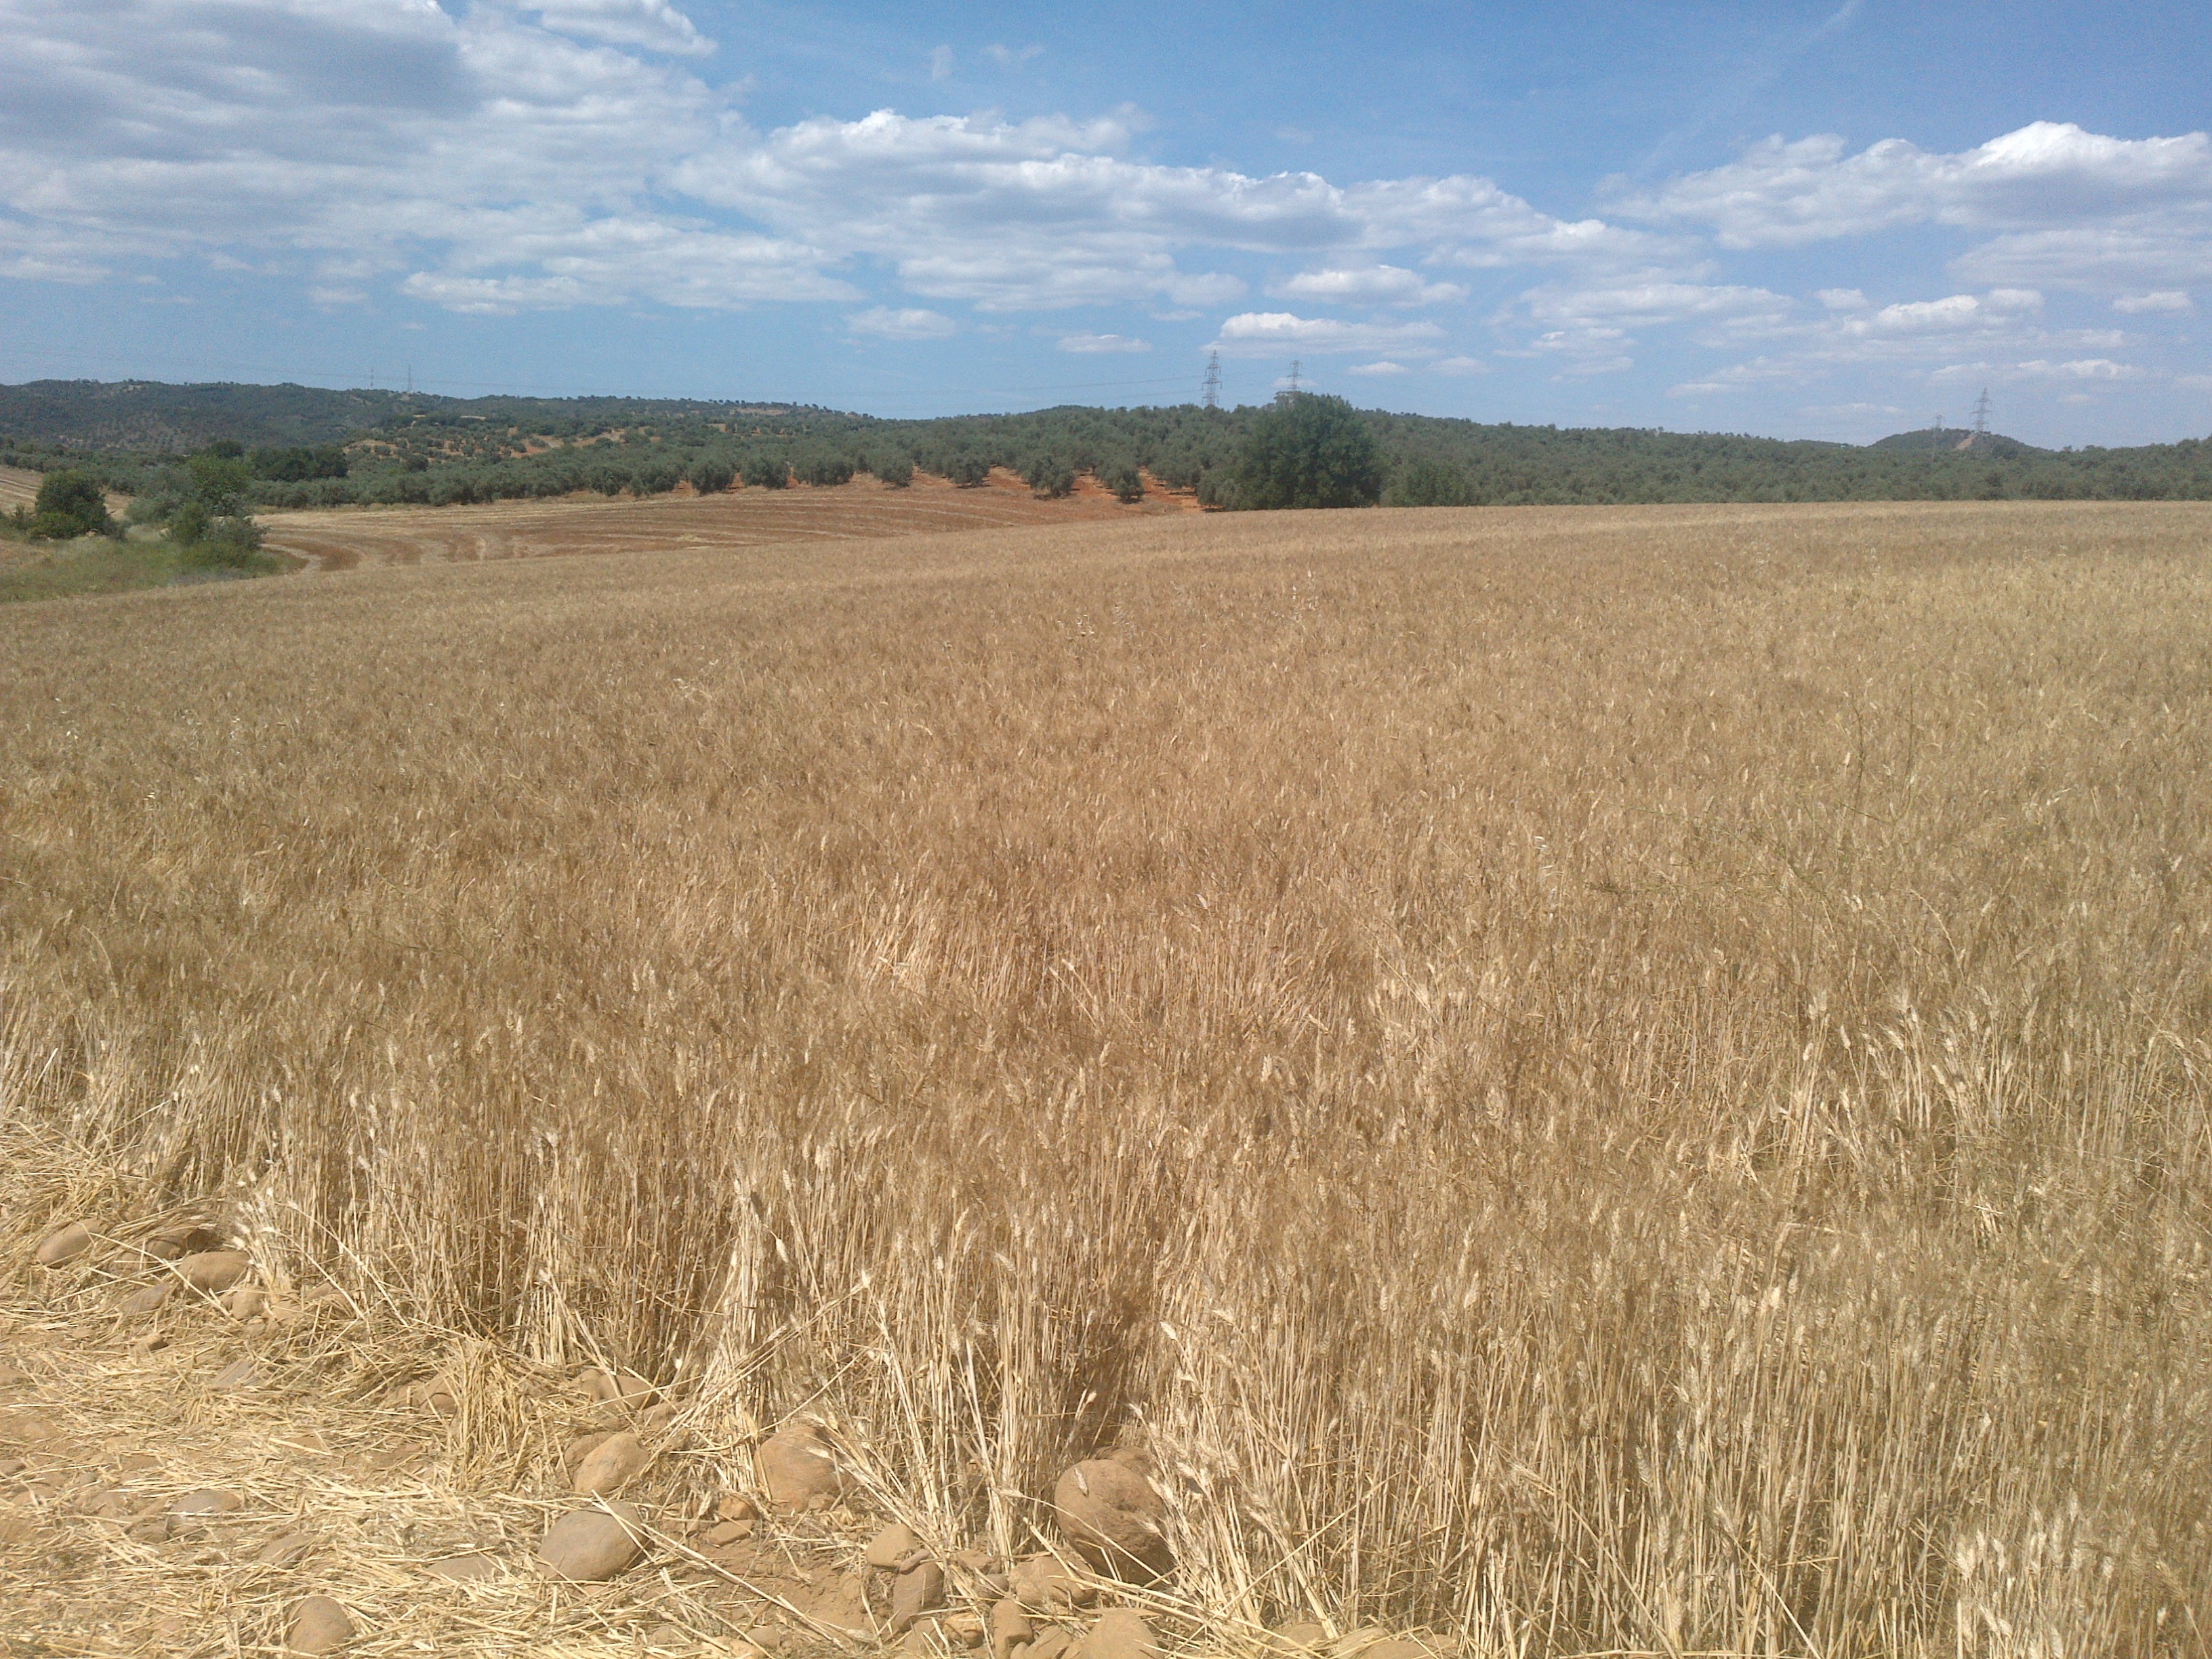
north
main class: Cropland
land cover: Olive groves
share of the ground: 50 - 75 %
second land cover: Spontaneously vegetated surfaces
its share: 25 - 50 %
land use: Agriculture (excluding fallow land and kitchen gardens)
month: May
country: ES
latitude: 37.9610
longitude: -4.5704
